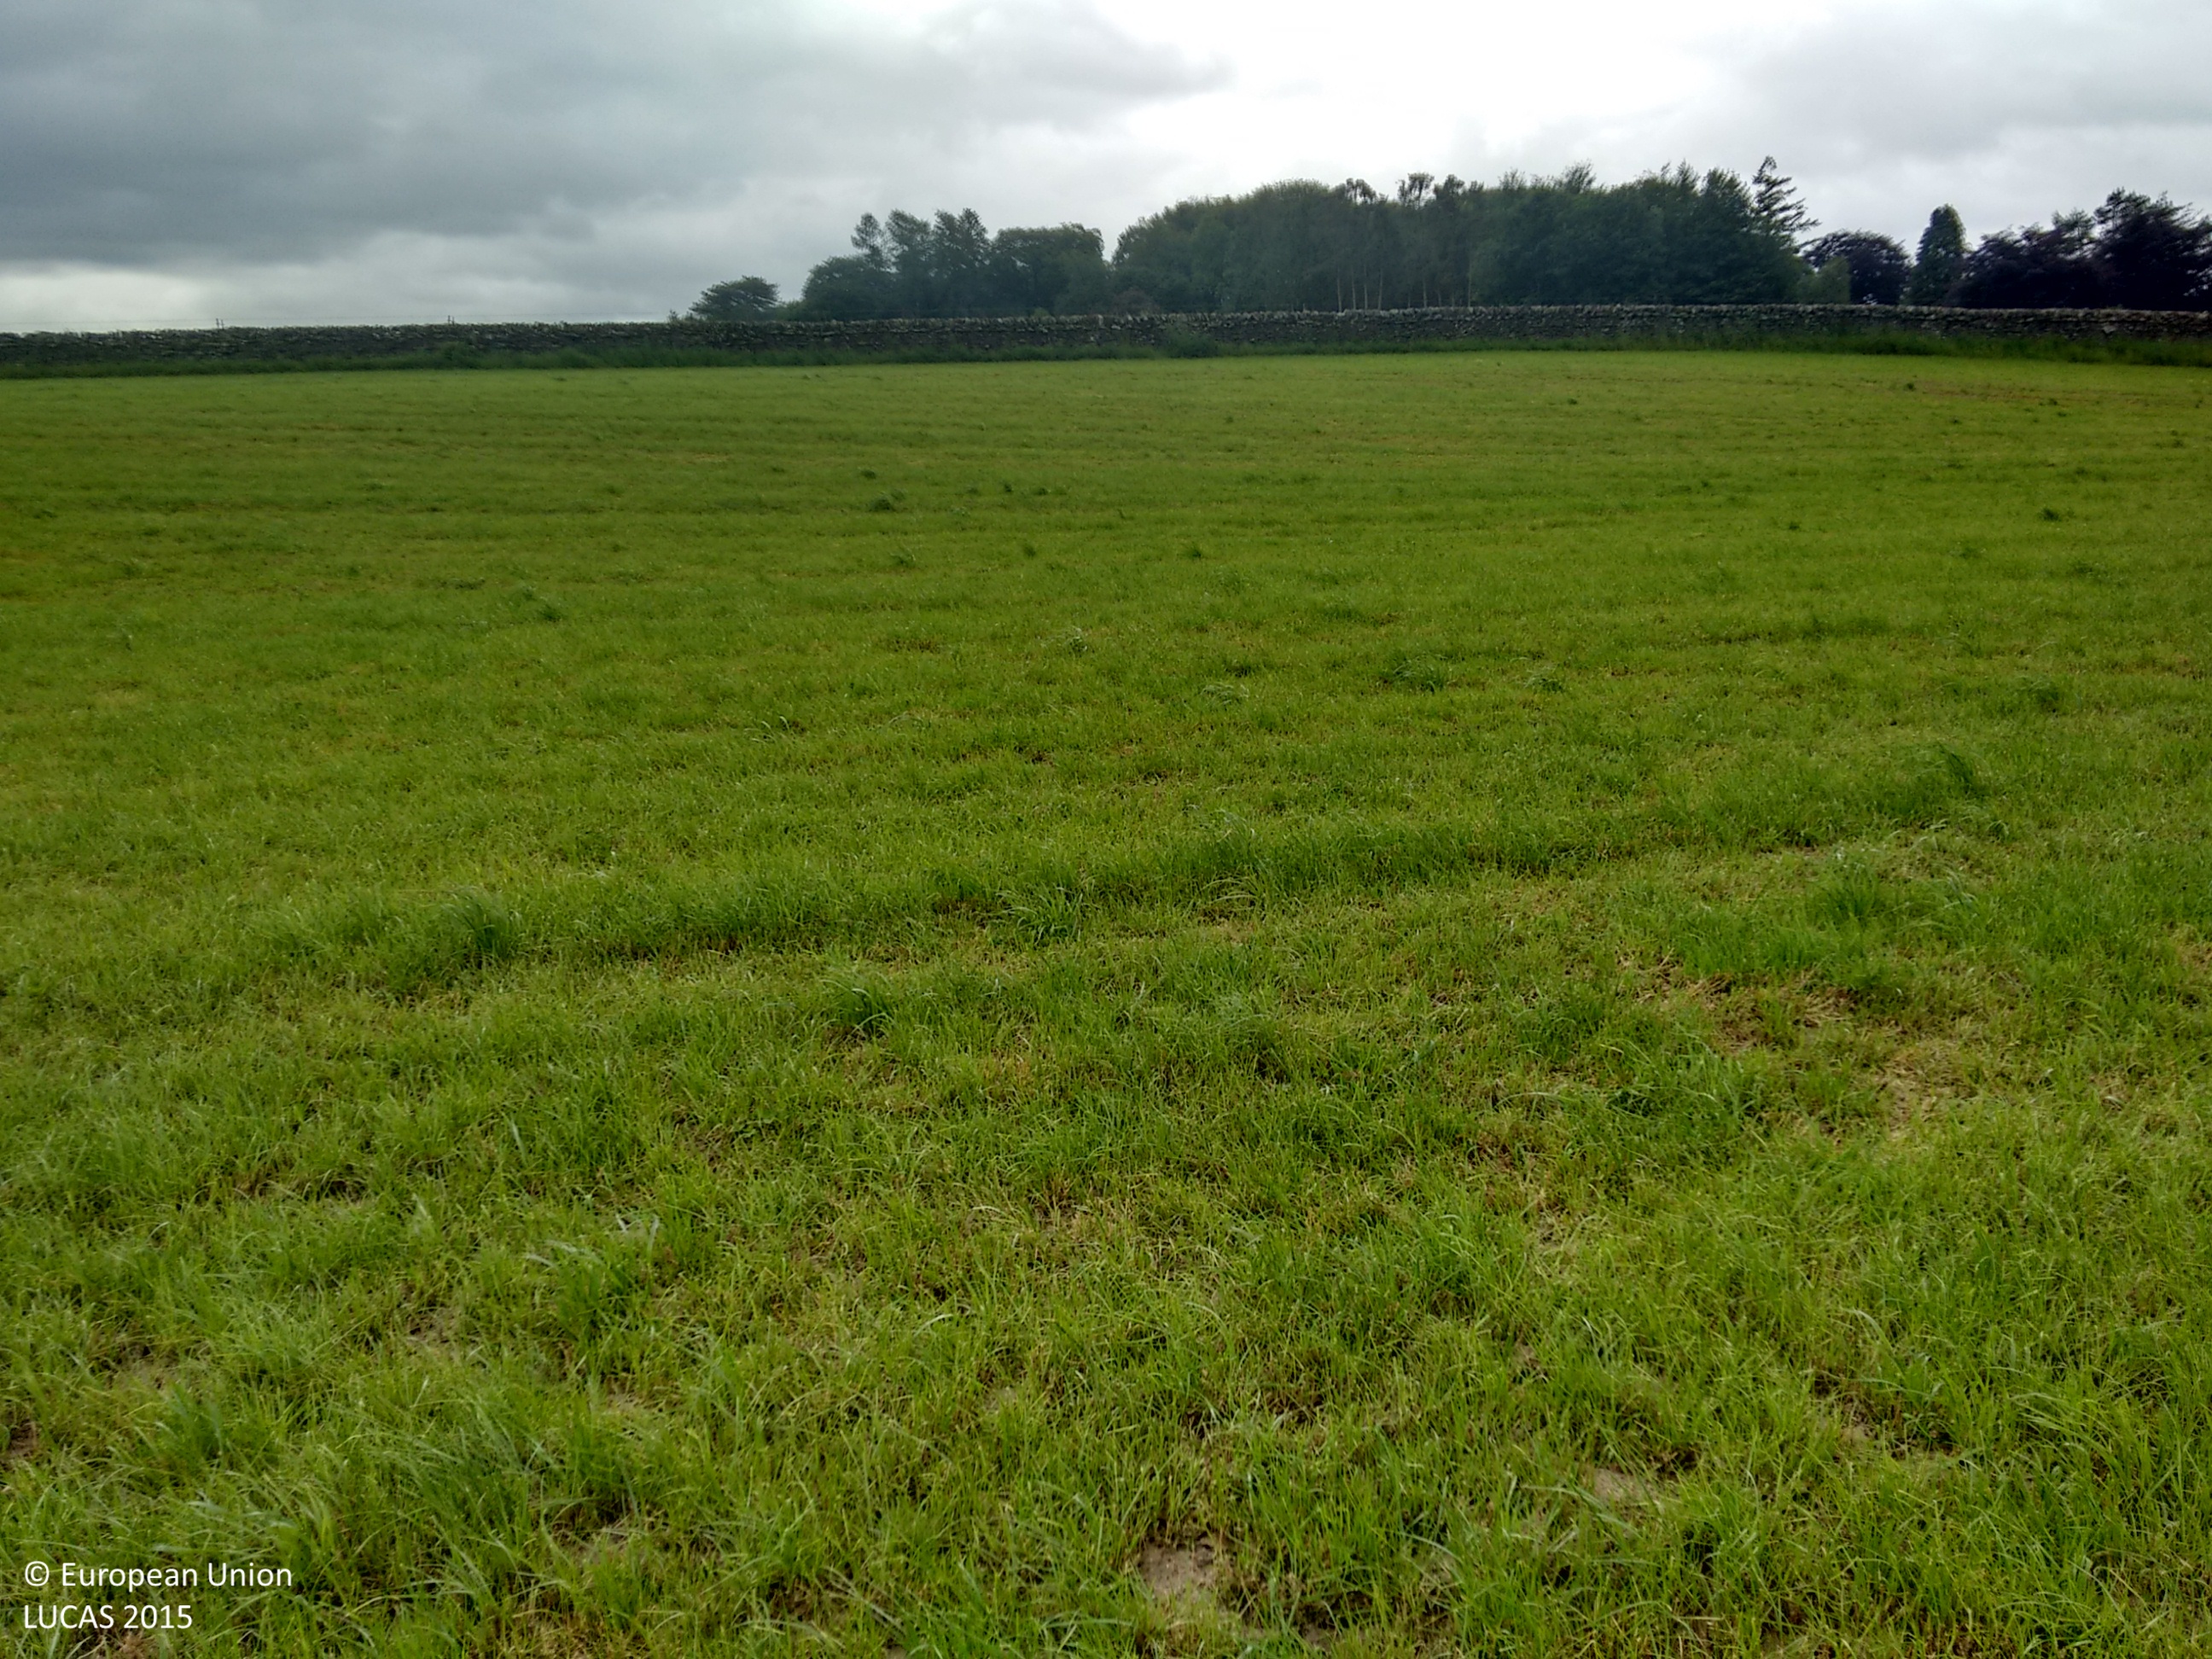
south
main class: Grassland
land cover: Grassland without tree/shrub cover
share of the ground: 50 - 75 %
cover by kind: herbaceous plants 90 %, unconsolidated bare surface 10 %
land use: Agriculture (excluding fallow land and kitchen gardens)
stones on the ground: < 10 %
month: June
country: GB
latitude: 55.2239
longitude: -3.7462
